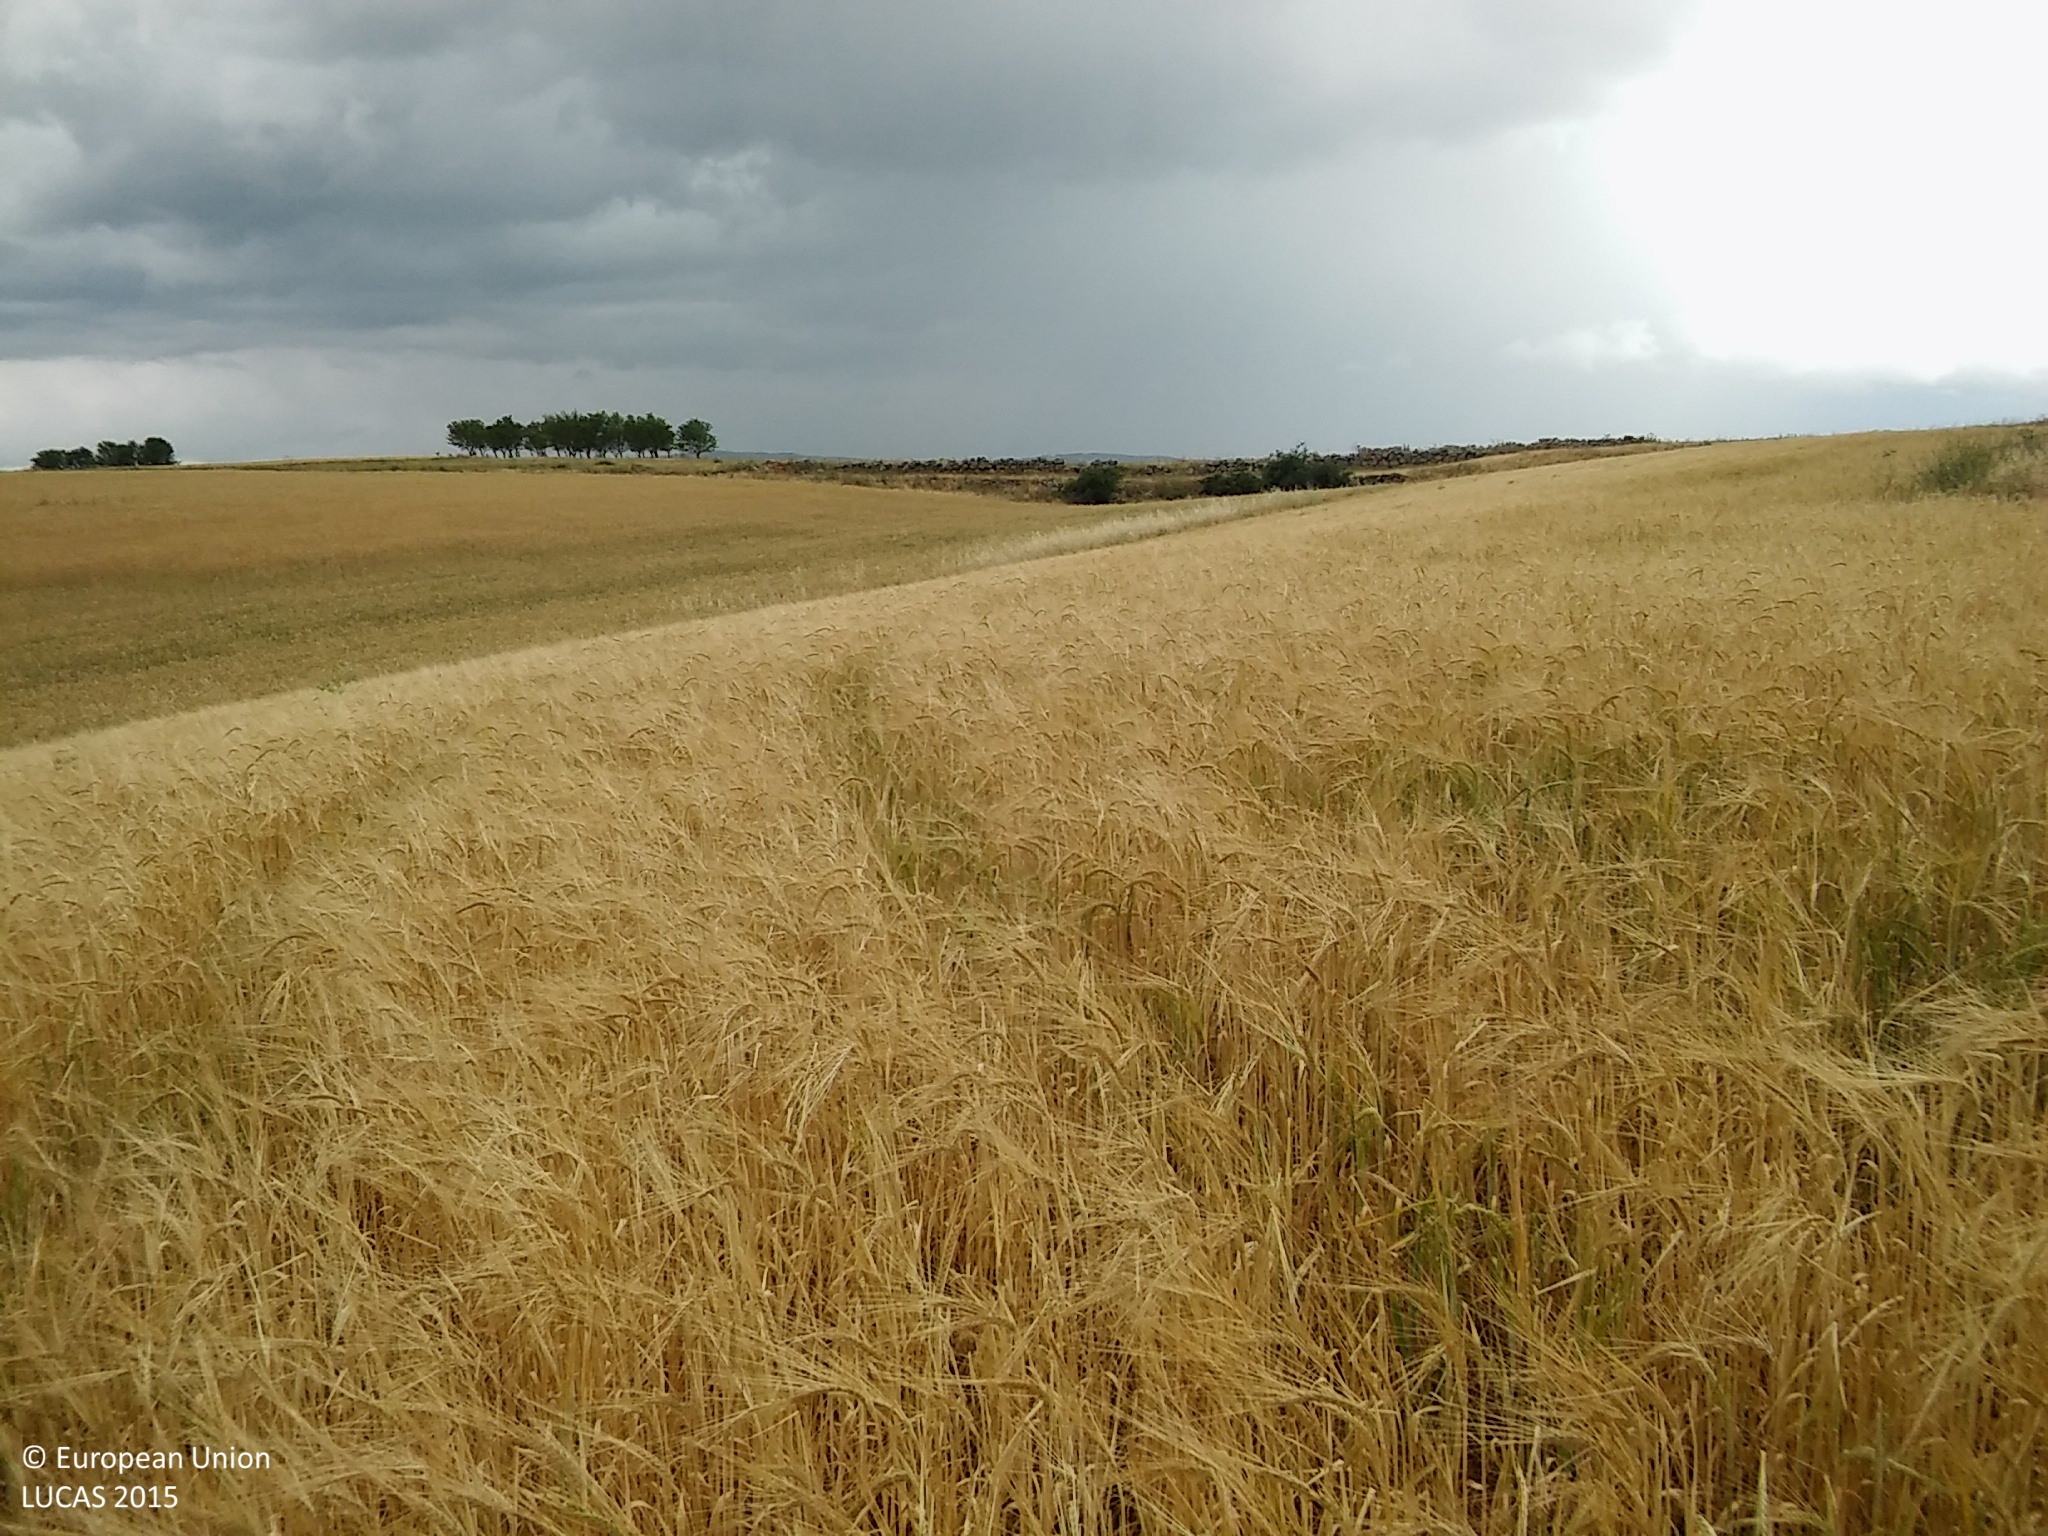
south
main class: Cropland
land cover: Barley
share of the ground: > 75 %
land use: Agriculture (excluding fallow land and kitchen gardens)
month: June
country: ES
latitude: 41.5282
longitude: -3.7505
